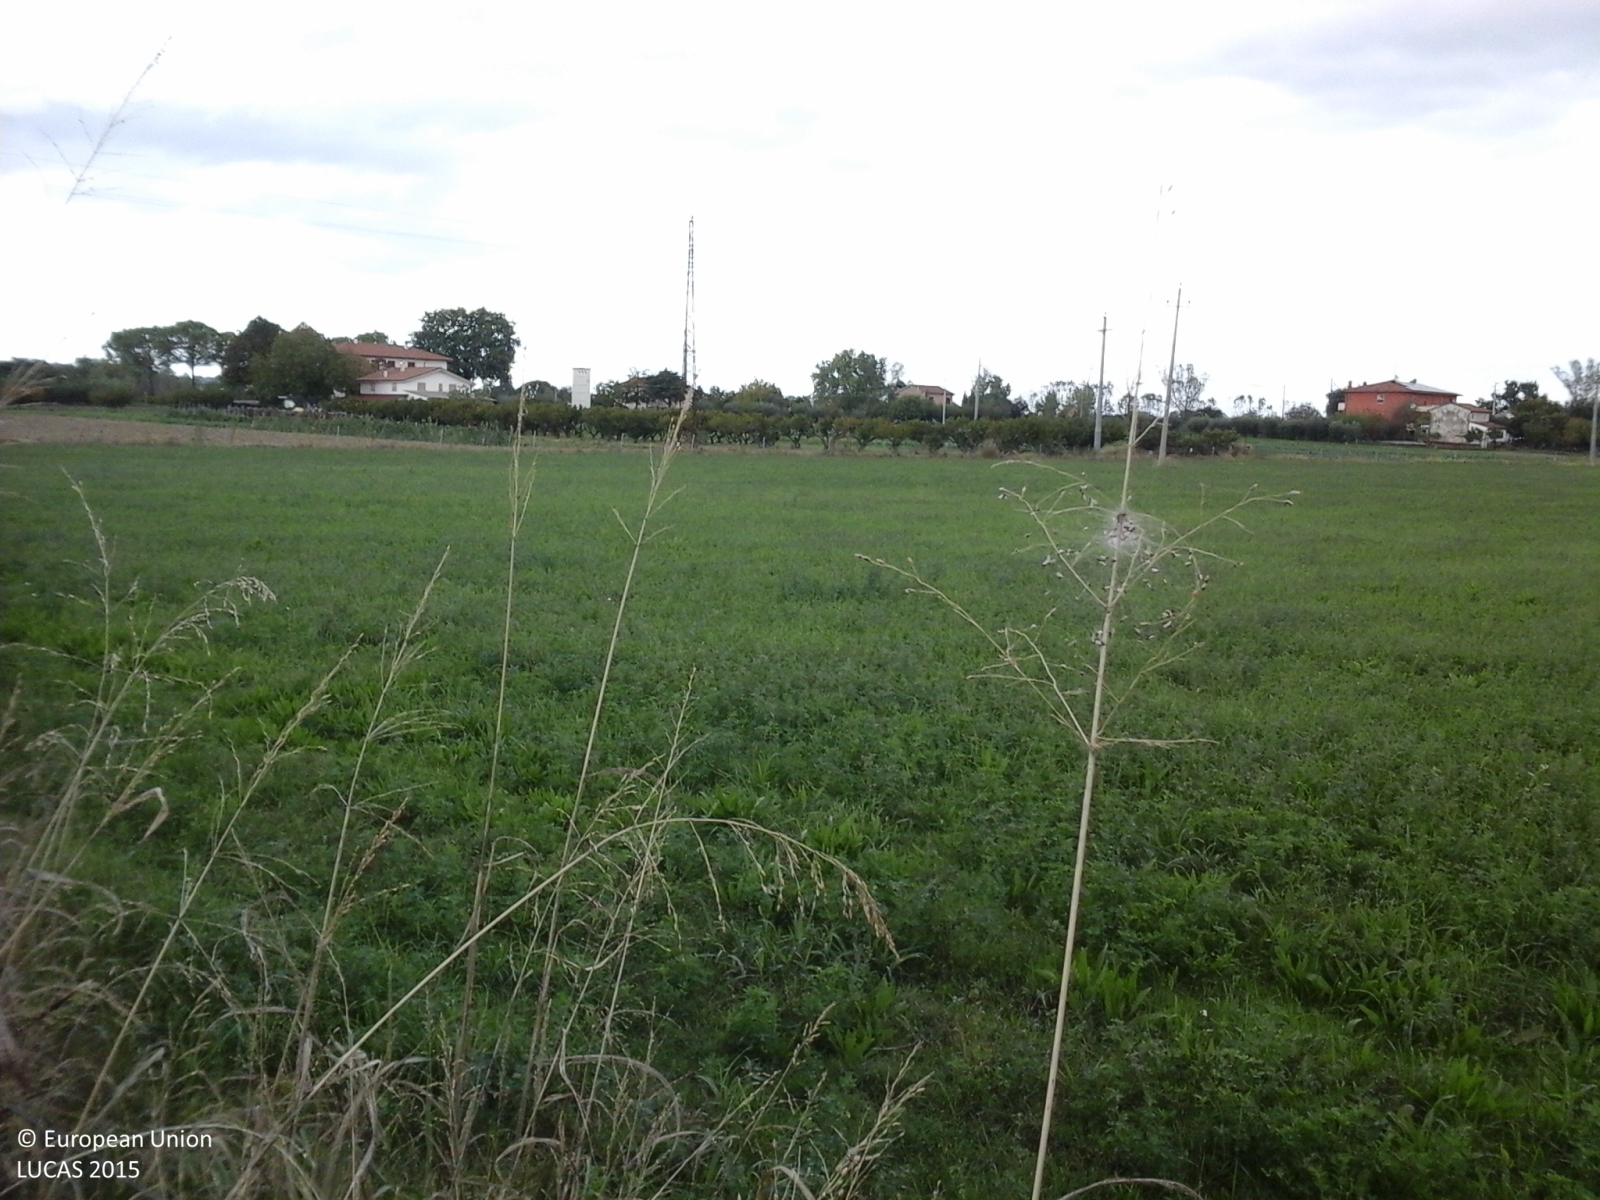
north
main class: Cropland
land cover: Lucerne
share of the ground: > 75 %
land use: Agriculture (excluding fallow land and kitchen gardens)
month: October
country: IT
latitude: 43.5227
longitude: 13.2706
